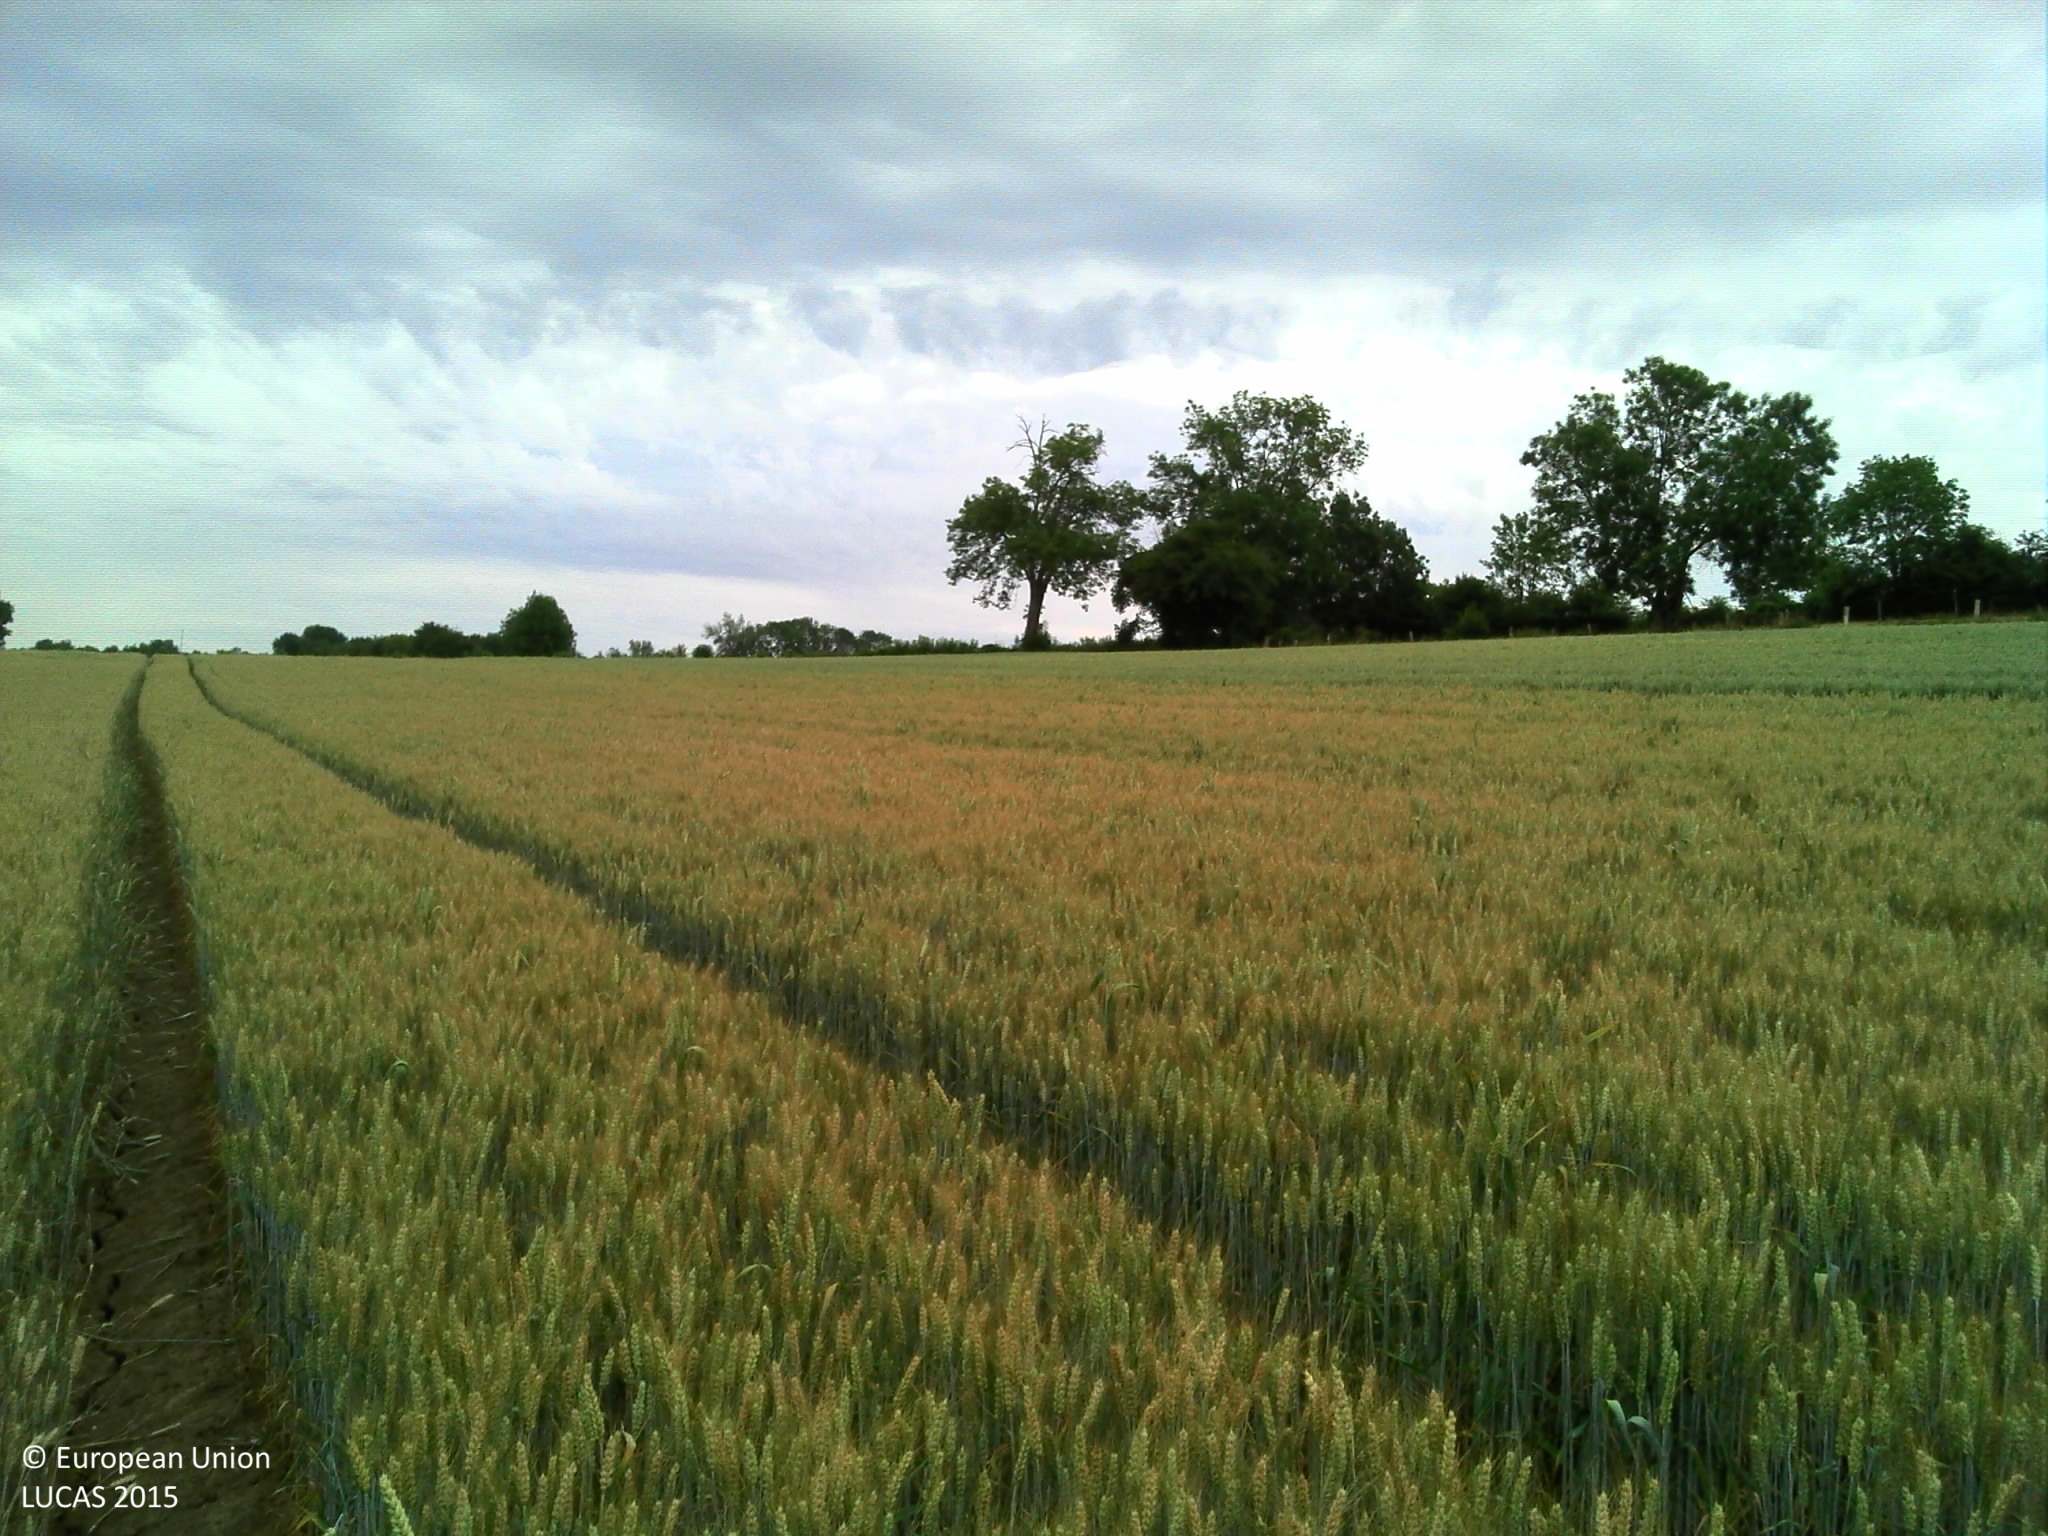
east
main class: Cropland
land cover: Common wheat
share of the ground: > 75 %
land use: Agriculture (excluding fallow land and kitchen gardens)
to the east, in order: Common wheat; Abandoned hedges; Fences; Grass margins; Paved roads, cycling and walking lanes; Grass margins; Common wheat
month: July
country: FR
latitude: 49.4906
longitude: 1.7971
